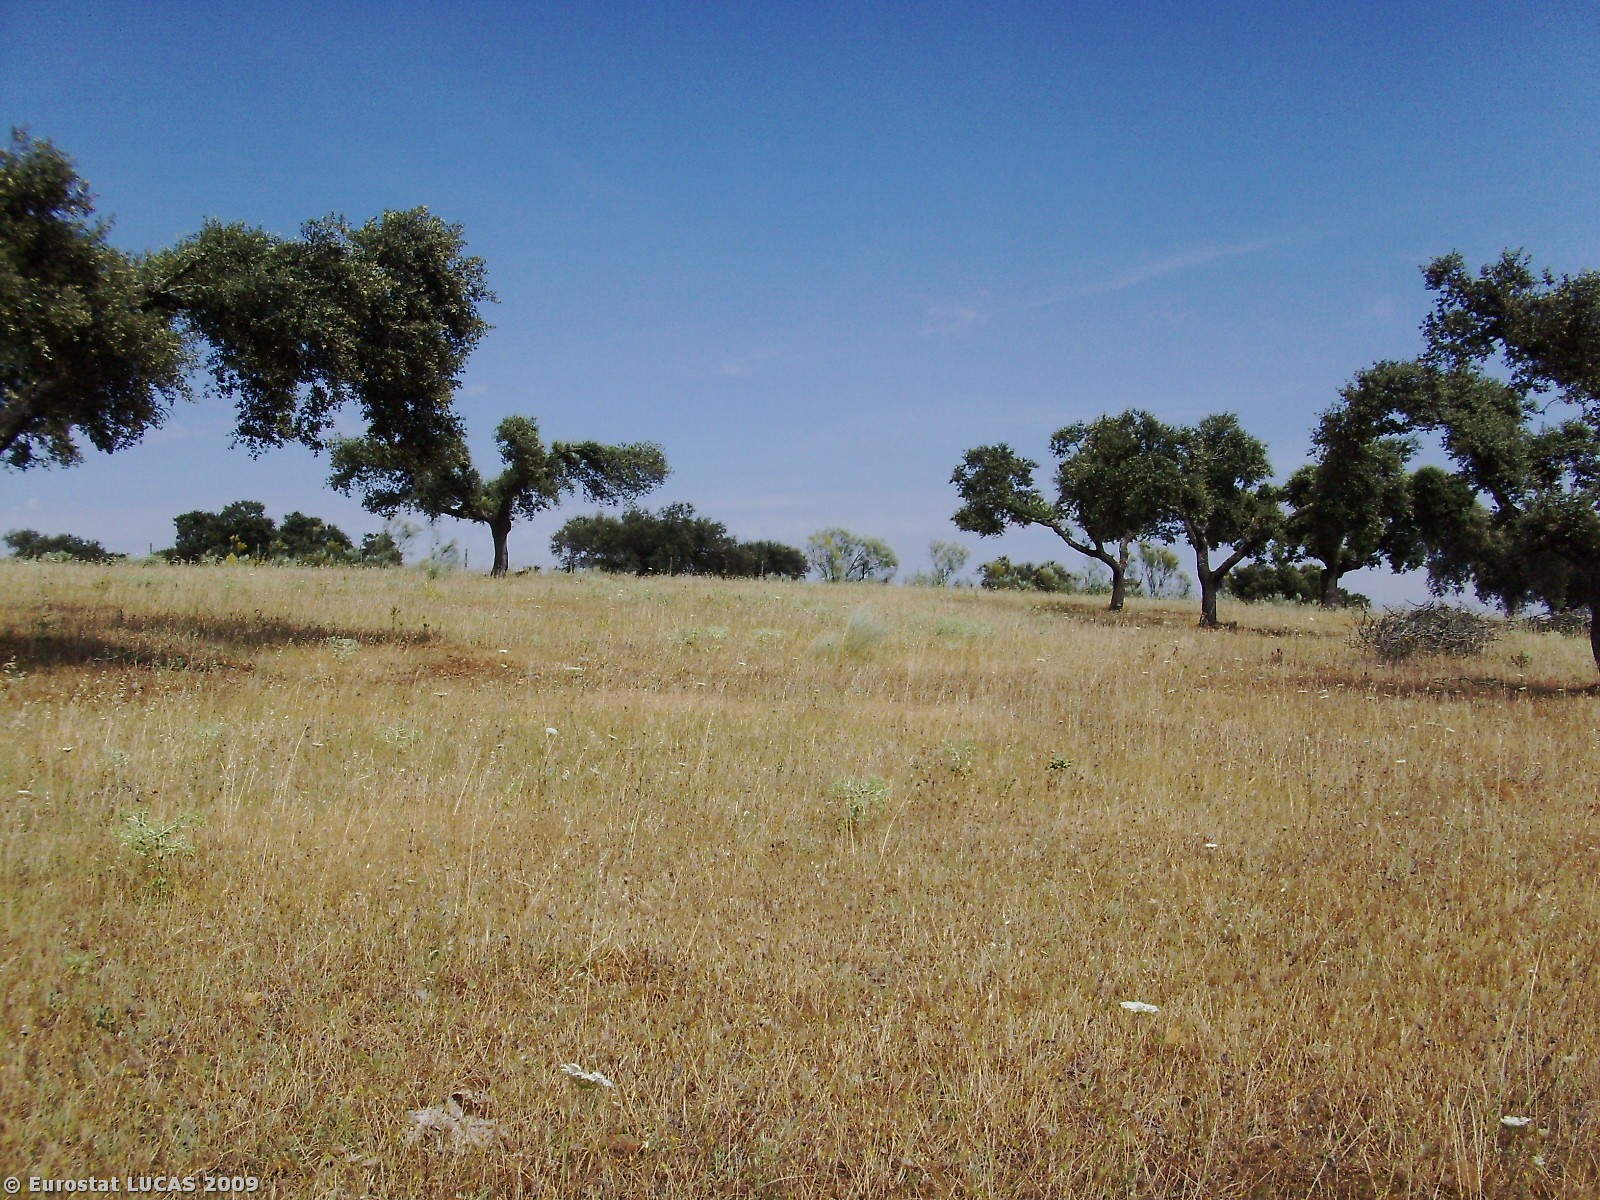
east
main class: Woodland
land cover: Broadleaved woodland
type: broadleaved evergreen forest
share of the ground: 10 - 25 %
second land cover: Spontaneously vegetated surfaces
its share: 50 - 75 %
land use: Forestry
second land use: Fallow land
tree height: > 5 m
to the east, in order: Broadleaved woodland; Spontaneously vegetated surfaces; Broadleaved woodland; Spontaneously vegetated surfaces; Fences; Bare land; Grassland with sparse tree/shrub cover; Tracks; Broadleaved woodland
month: June
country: PT
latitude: 39.1101
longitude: -7.3722
